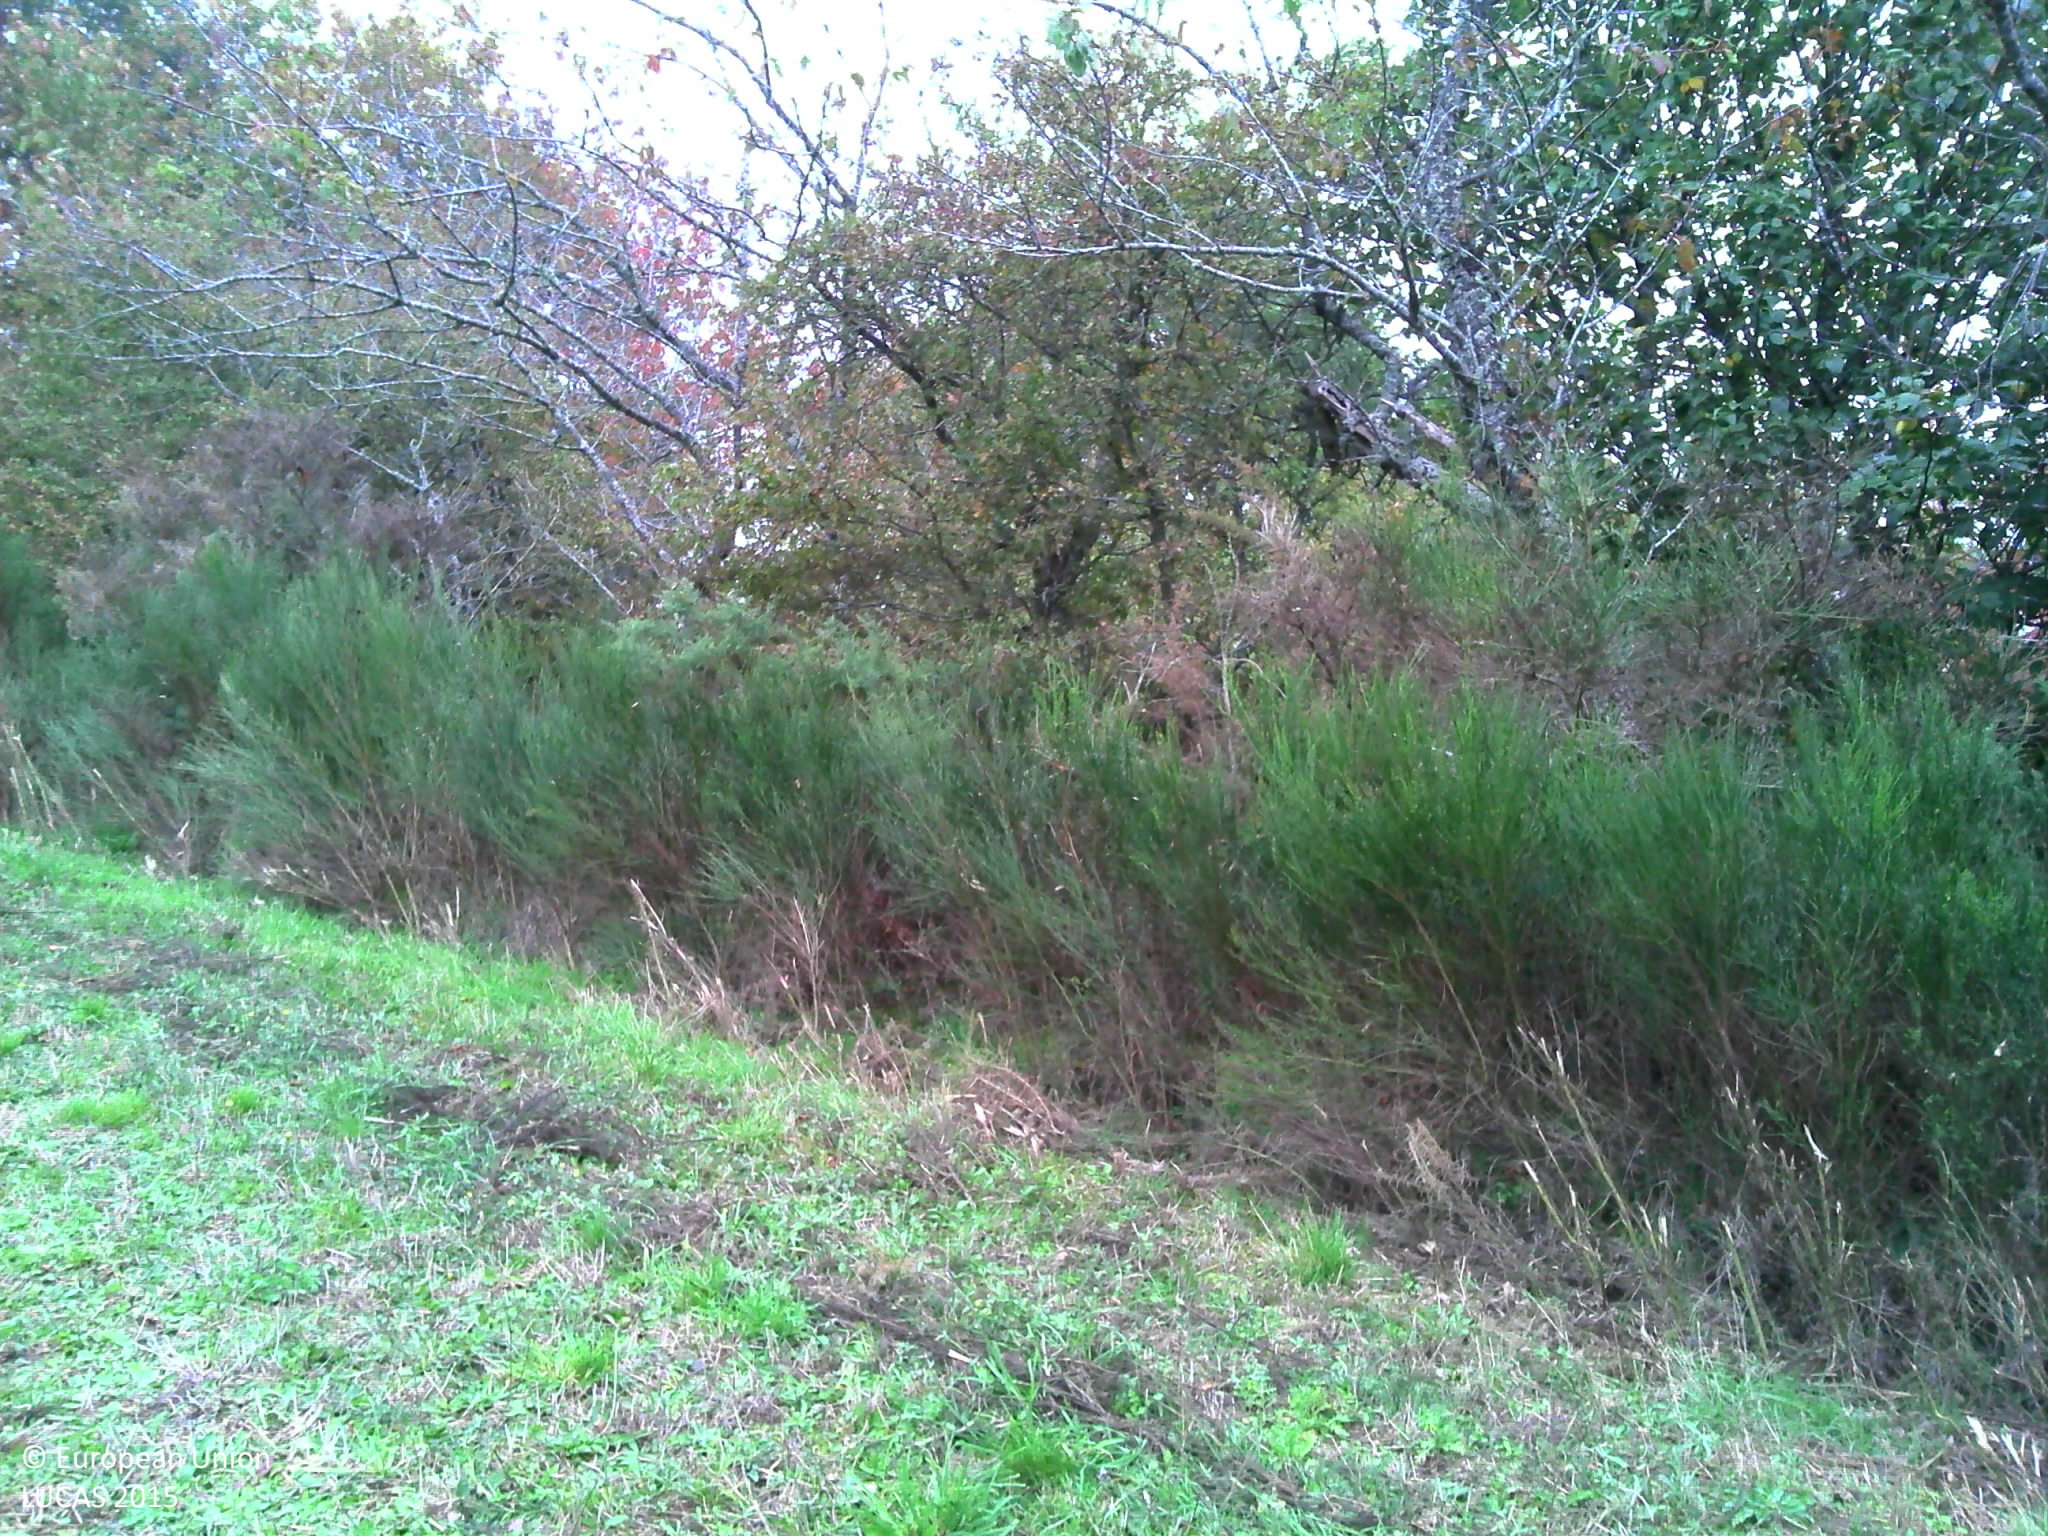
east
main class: Grassland
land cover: Grassland without tree/shrub cover
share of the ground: > 75 %
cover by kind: herbaceous plants 100 %
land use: Agriculture (excluding fallow land and kitchen gardens)
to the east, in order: Grassland without tree/shrub cover; Broadleaved woodland; Shrubland with sparse tree cover; Pine dominated mixed woodland; Fences; Grassland without tree/shrub cover; Broadleaved woodland; Grassland without tree/shrub cover; Abandoned hedges; Fences; Grassland without tree/shrub cover; Single bushes/trees
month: October
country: FR
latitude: 46.0516
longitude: 3.0324
